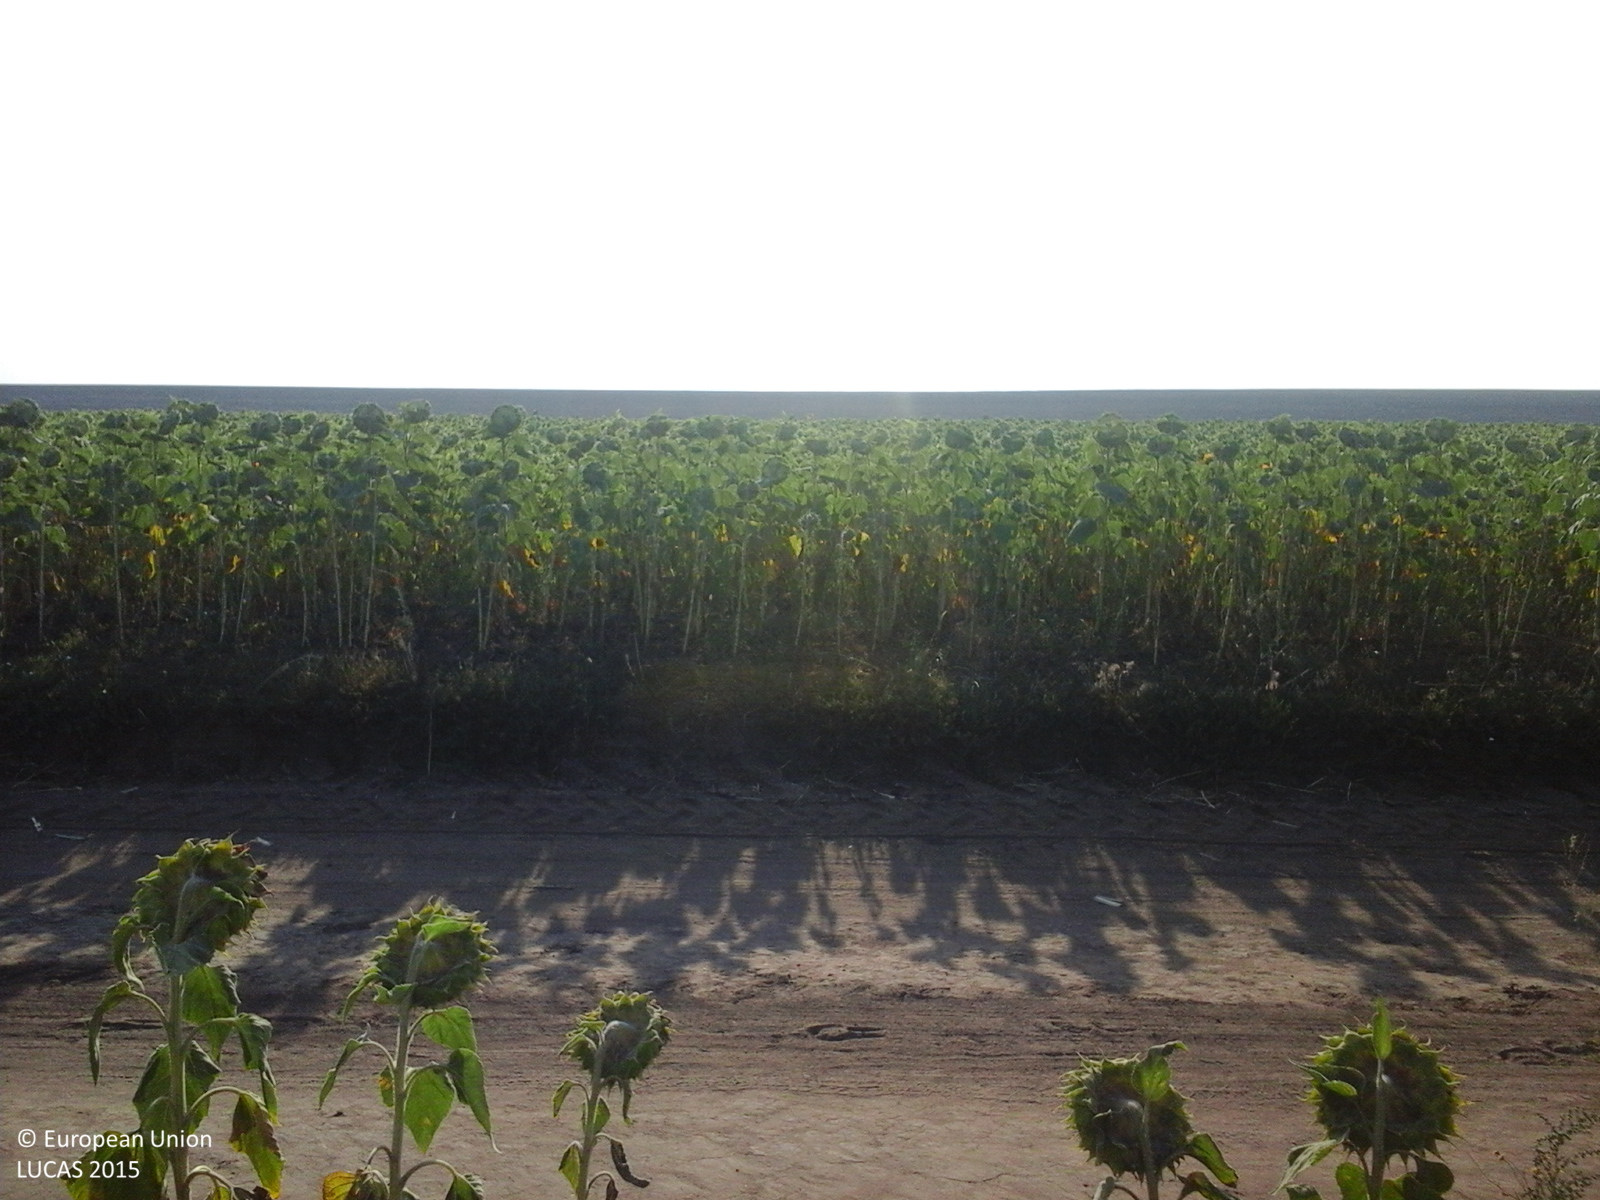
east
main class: Cropland
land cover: Sunflower
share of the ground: > 75 %
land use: Agriculture (excluding fallow land and kitchen gardens)
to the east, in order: Sunflower
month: July
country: RO
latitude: 45.9654
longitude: 27.8077
